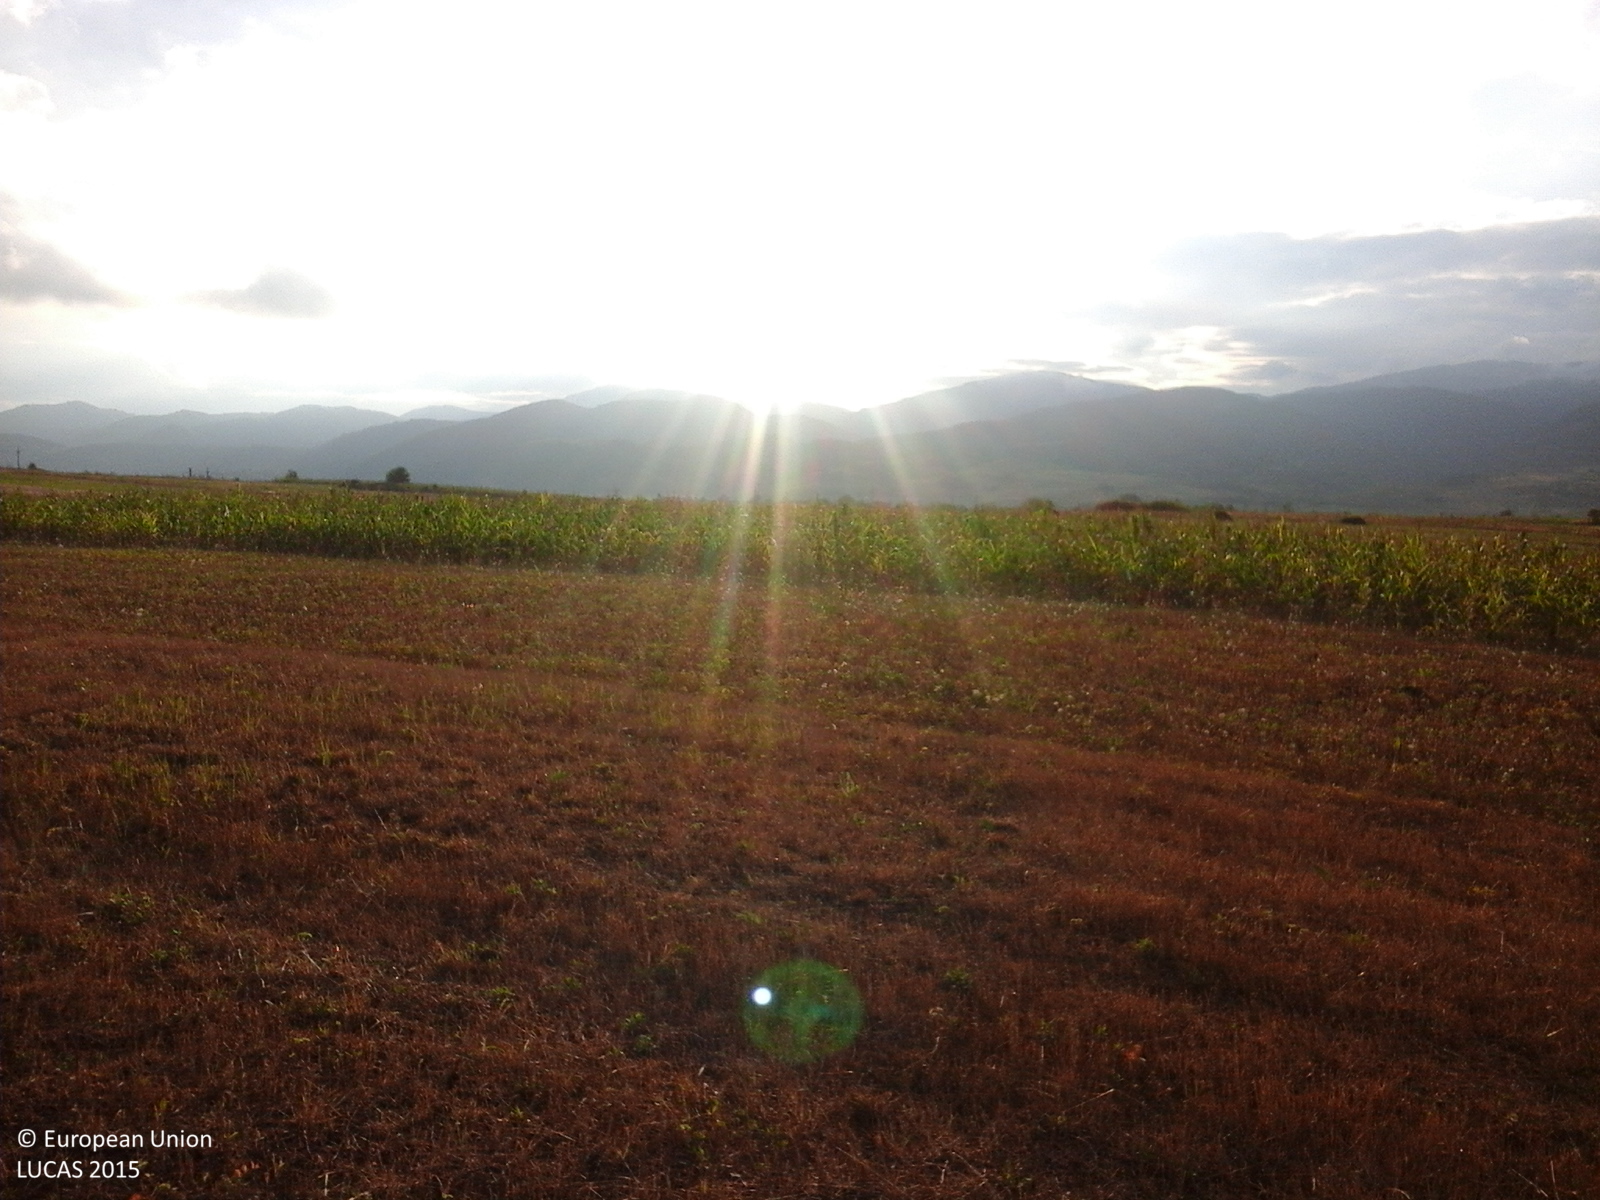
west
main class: Grassland
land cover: Grassland without tree/shrub cover
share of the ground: > 75 %
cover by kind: herbaceous plants 100 %
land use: Agriculture (excluding fallow land and kitchen gardens)
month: August
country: RO
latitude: 44.8752
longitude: 21.9709
